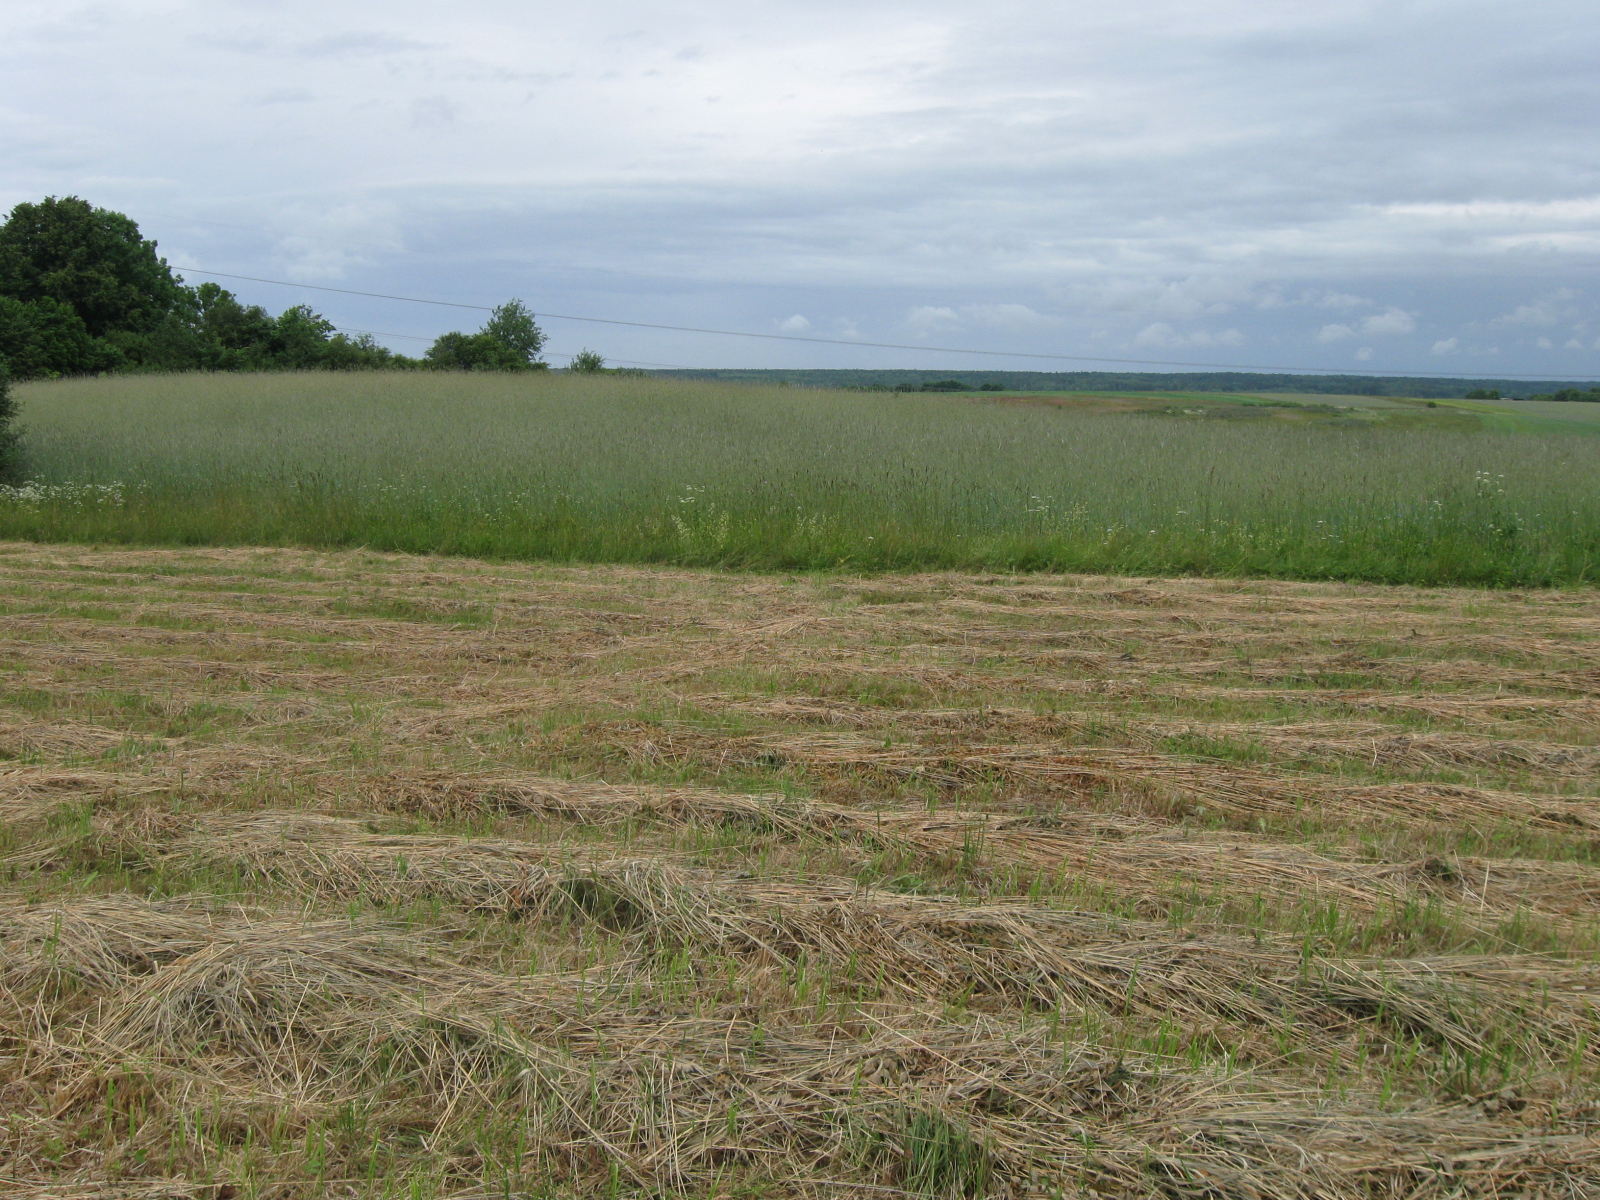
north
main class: Grassland
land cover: Grassland without tree/shrub cover
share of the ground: > 75 %
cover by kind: herbaceous plants 90 %, unconsolidated bare surface 10 %
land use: Agriculture (excluding fallow land and kitchen gardens)
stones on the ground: < 10 %
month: June
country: LT
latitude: 54.7709
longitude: 24.5124
